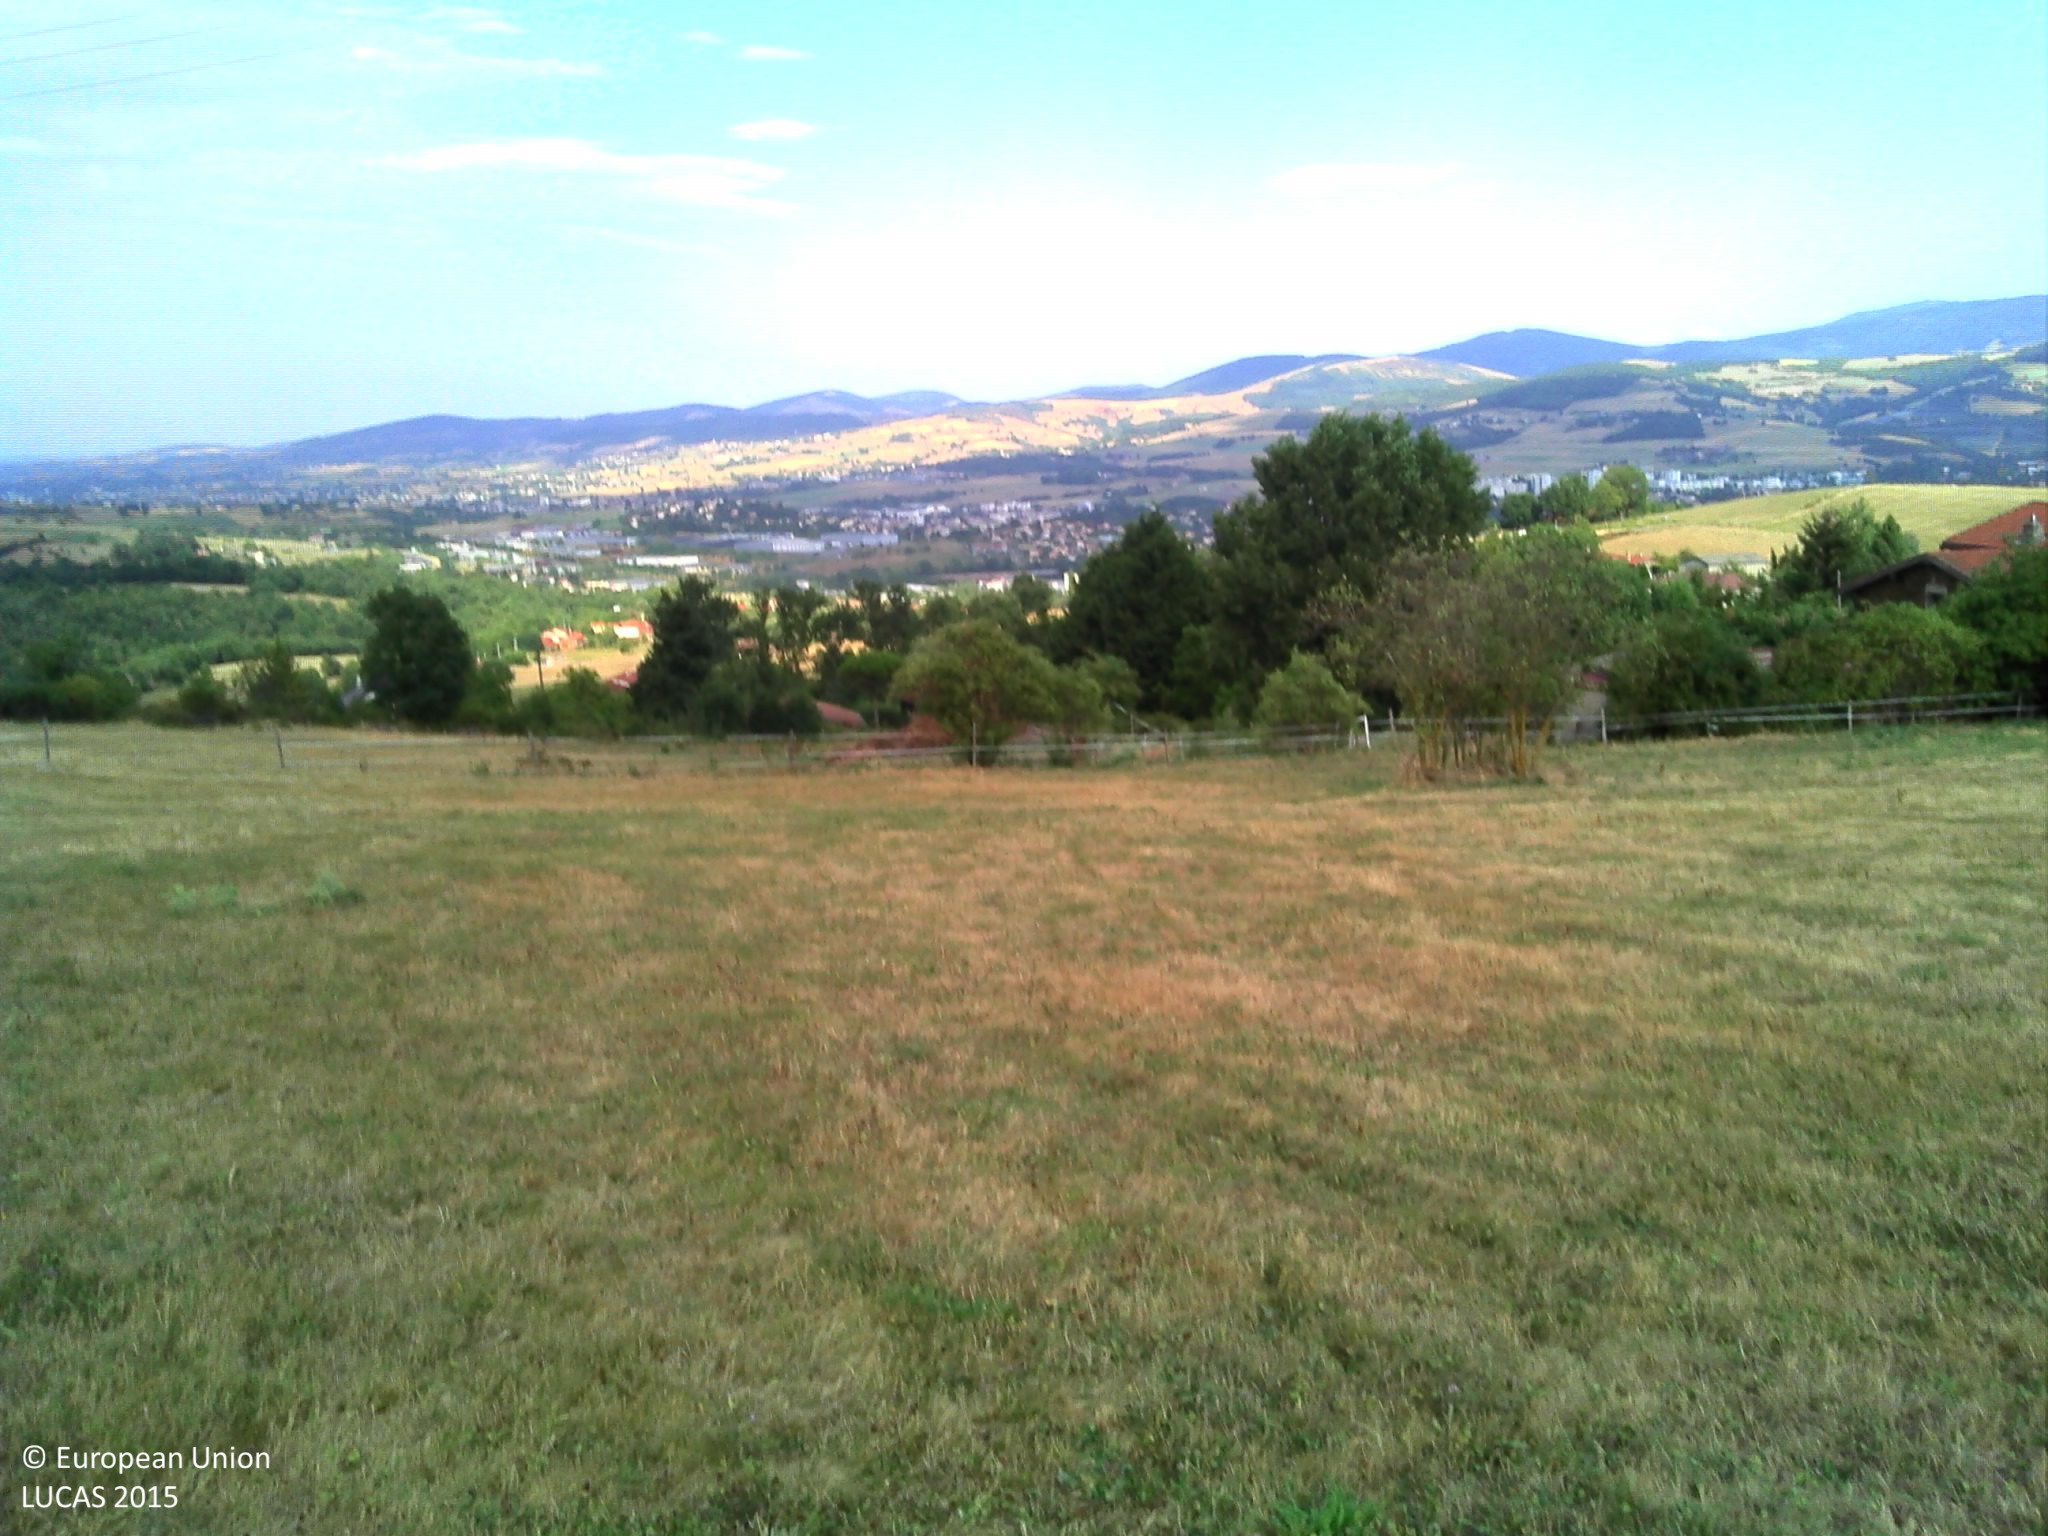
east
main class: Grassland
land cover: Grassland without tree/shrub cover
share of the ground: > 75 %
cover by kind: herbaceous plants 100 %
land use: Agriculture (excluding fallow land and kitchen gardens)
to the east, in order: Grassland without tree/shrub cover; Fences; Grassland without tree/shrub cover; Broadleaved woodland; Artificial constructions in urban areas; Broadleaved woodland; Grassland without tree/shrub cover; Broadleaved woodland
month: August
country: FR
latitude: 45.4869
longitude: 4.4893
